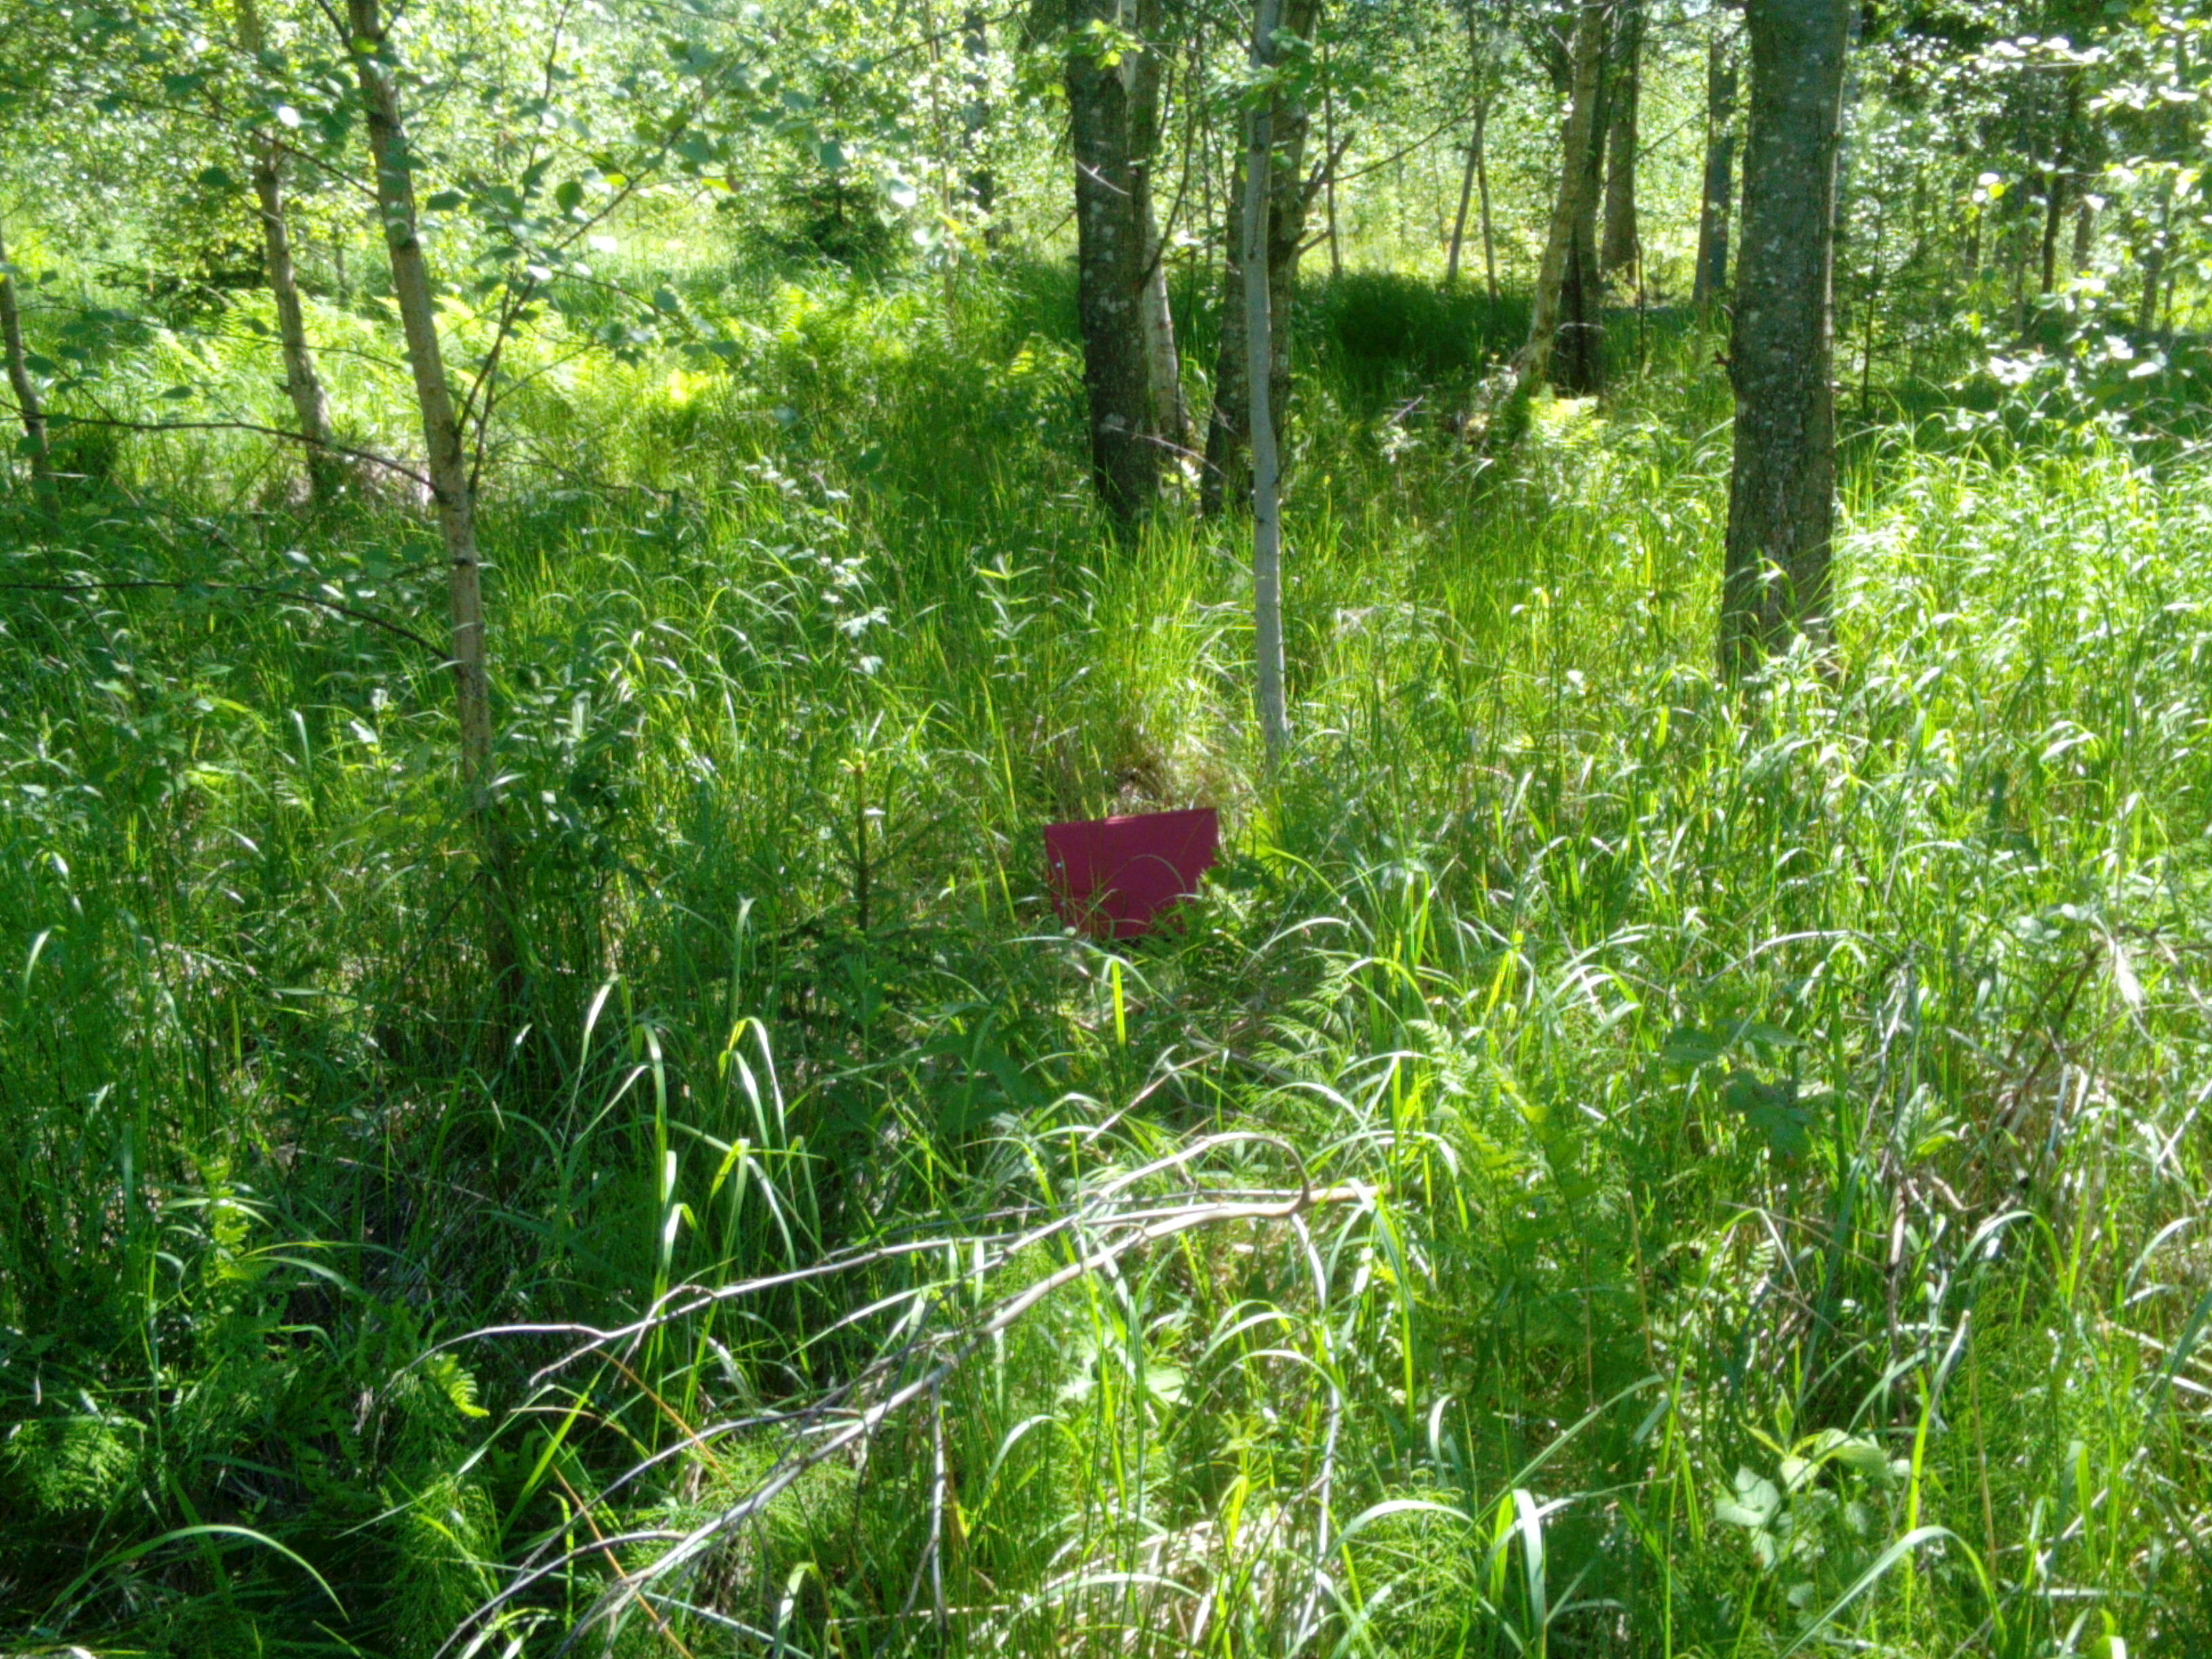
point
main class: Woodland
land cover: Broadleaved woodland
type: non-riverine alder, birch or aspen forest
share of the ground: 50 - 75 %
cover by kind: broadleaved forest trees 45 %, herbaceous plants 40 %, shrubs 10 %, coniferous forest trees 5 %
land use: Forestry
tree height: > 5 m
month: June
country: LV
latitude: 56.6379
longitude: 22.2319
